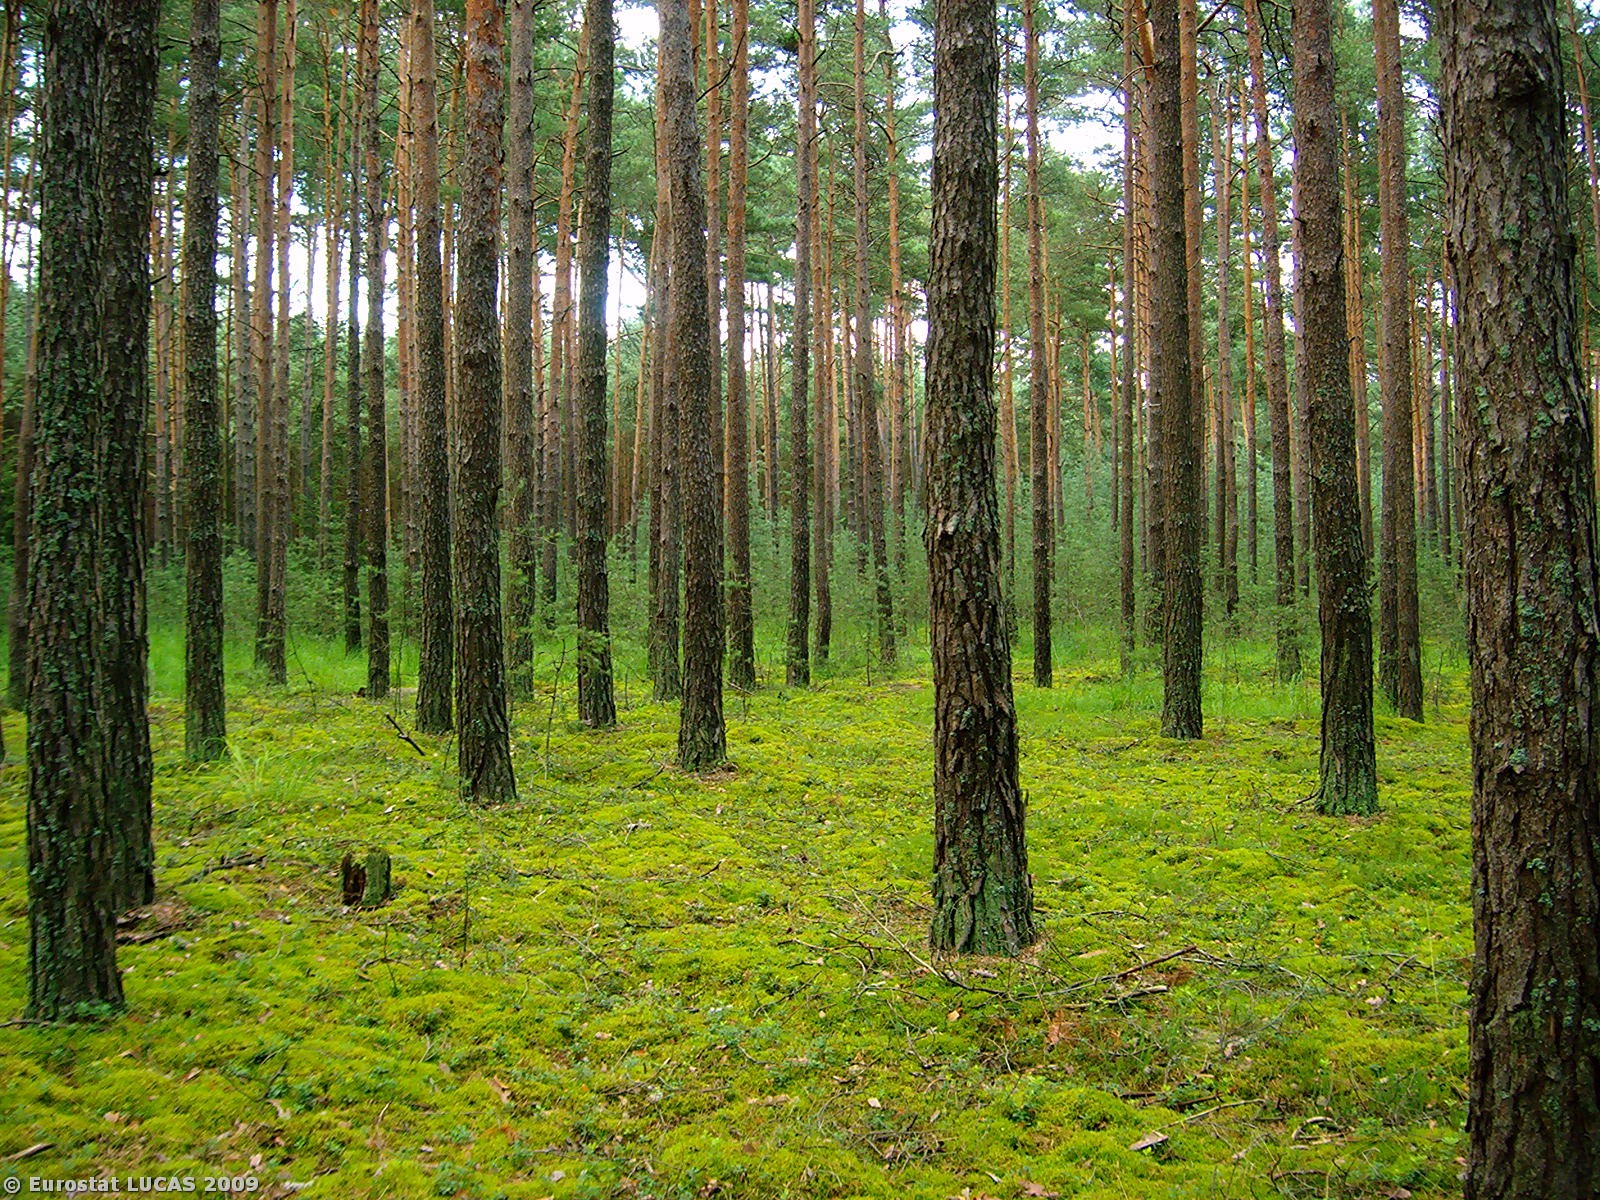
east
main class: Woodland
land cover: Coniferous woodland
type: hemiboreal forest and nemoral coniferous forest and mixed broadleaved-coniferous forest
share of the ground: 50 - 75 %
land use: Forestry
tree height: > 5 m
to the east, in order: Coniferous woodland; Tracks; Coniferous woodland; Fences; Coniferous woodland; Fences; Coniferous woodland
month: July
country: PL
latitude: 52.7183
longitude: 15.8823
